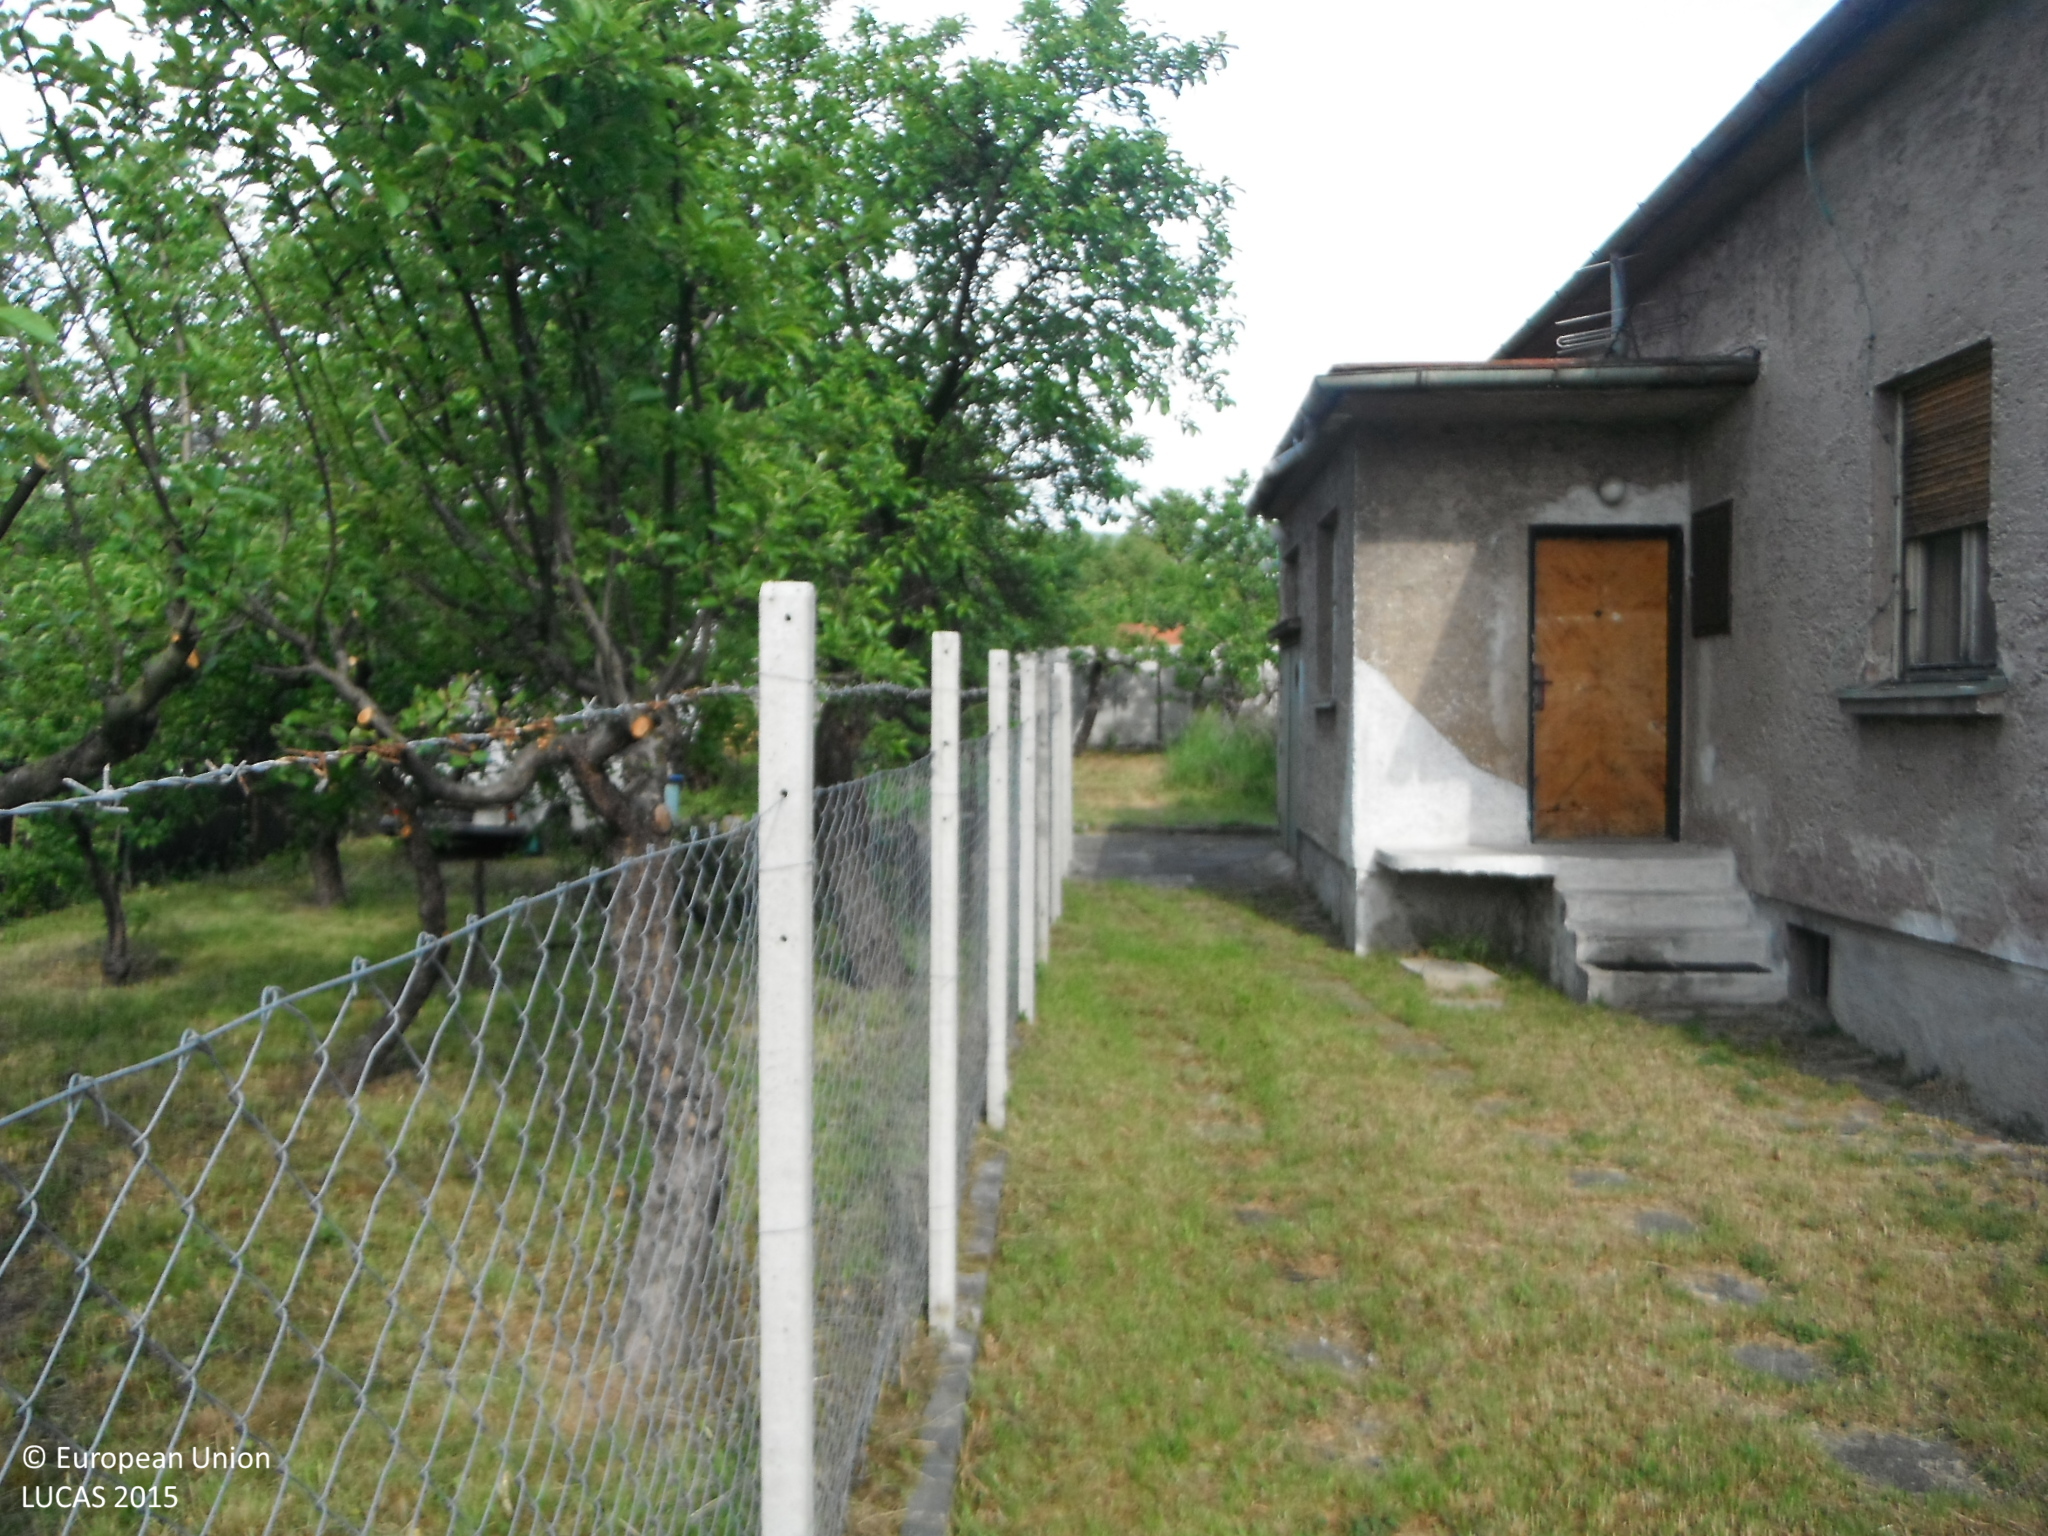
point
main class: Cropland
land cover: Apple fruit
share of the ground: > 75 %
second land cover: Grassland without tree/shrub cover
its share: > 75 %
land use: Kitchen garden
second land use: Residential
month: May
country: SK
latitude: 48.2078
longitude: 17.1537
